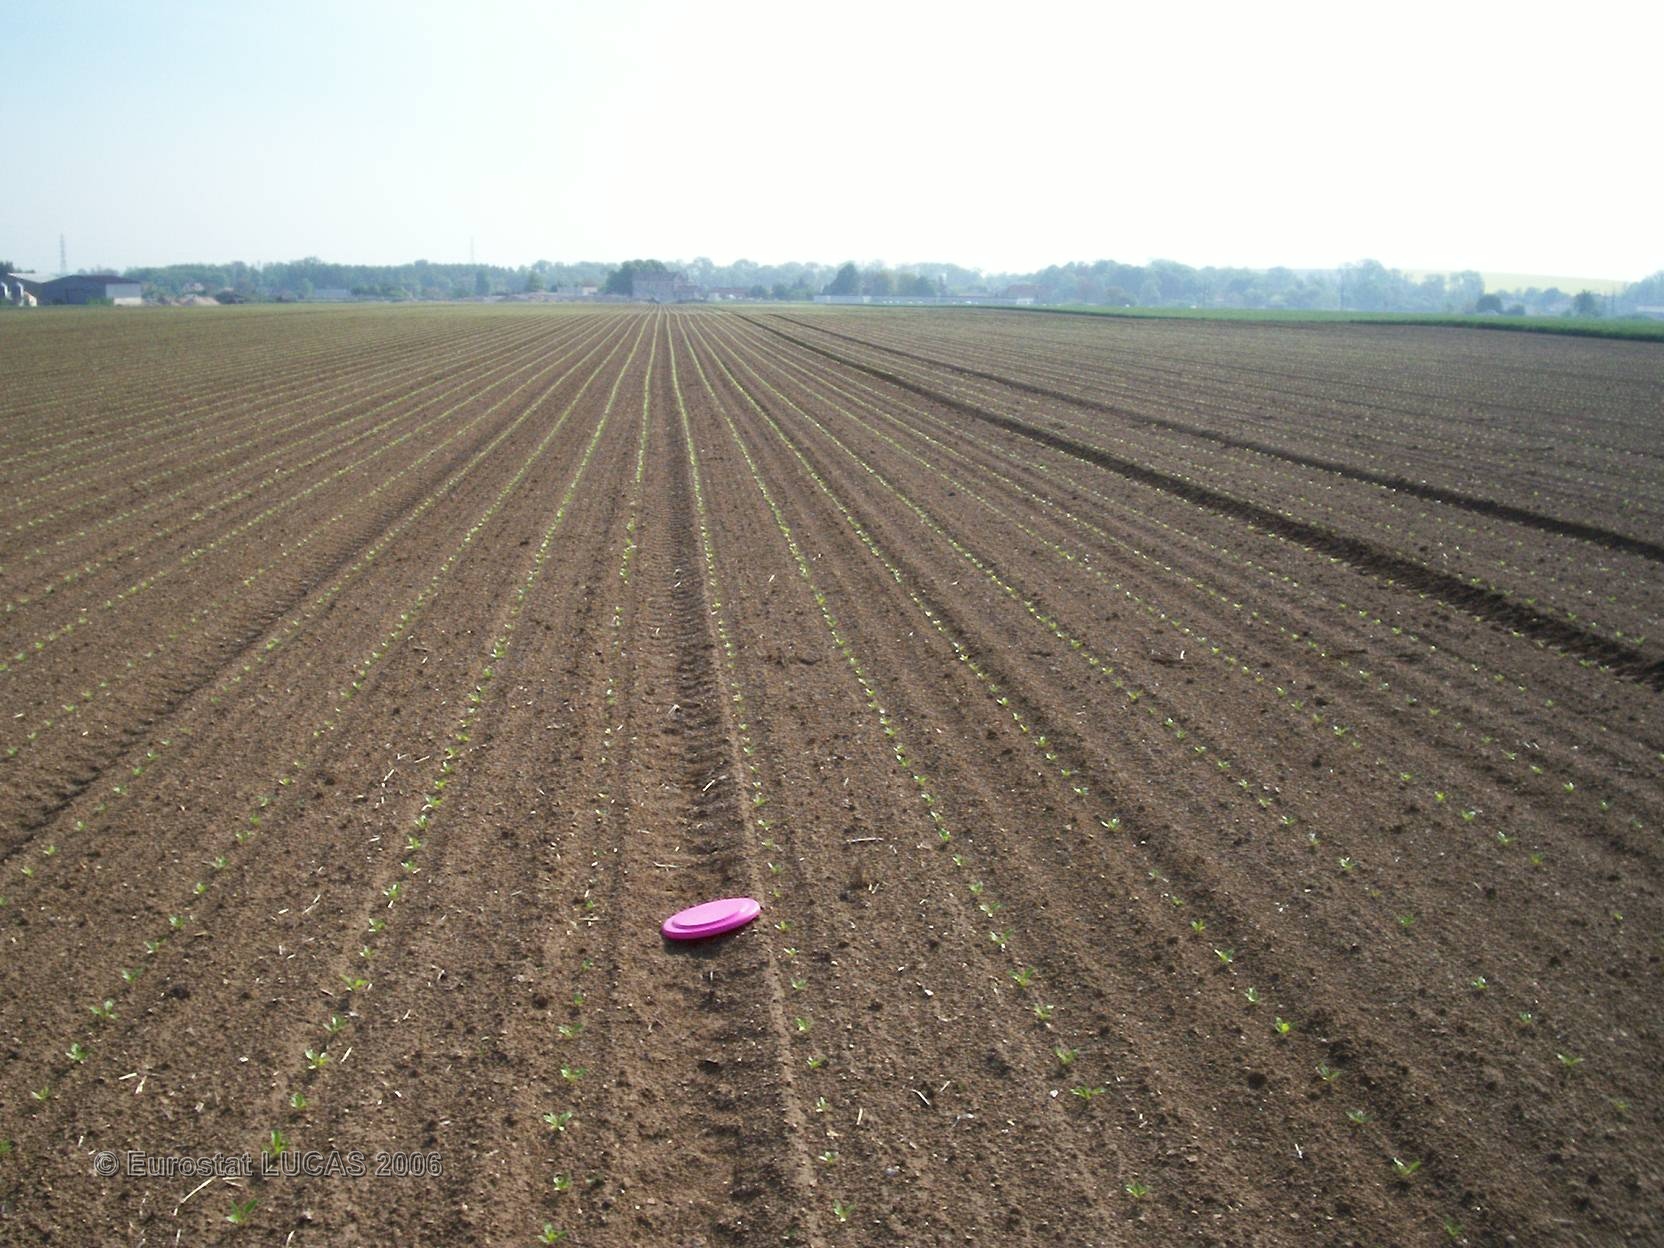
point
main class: Cropland
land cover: Sugar beet
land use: Agriculture (excluding fallow land and kitchen gardens)
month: May
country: FR
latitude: 49.0537
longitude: 4.3723
